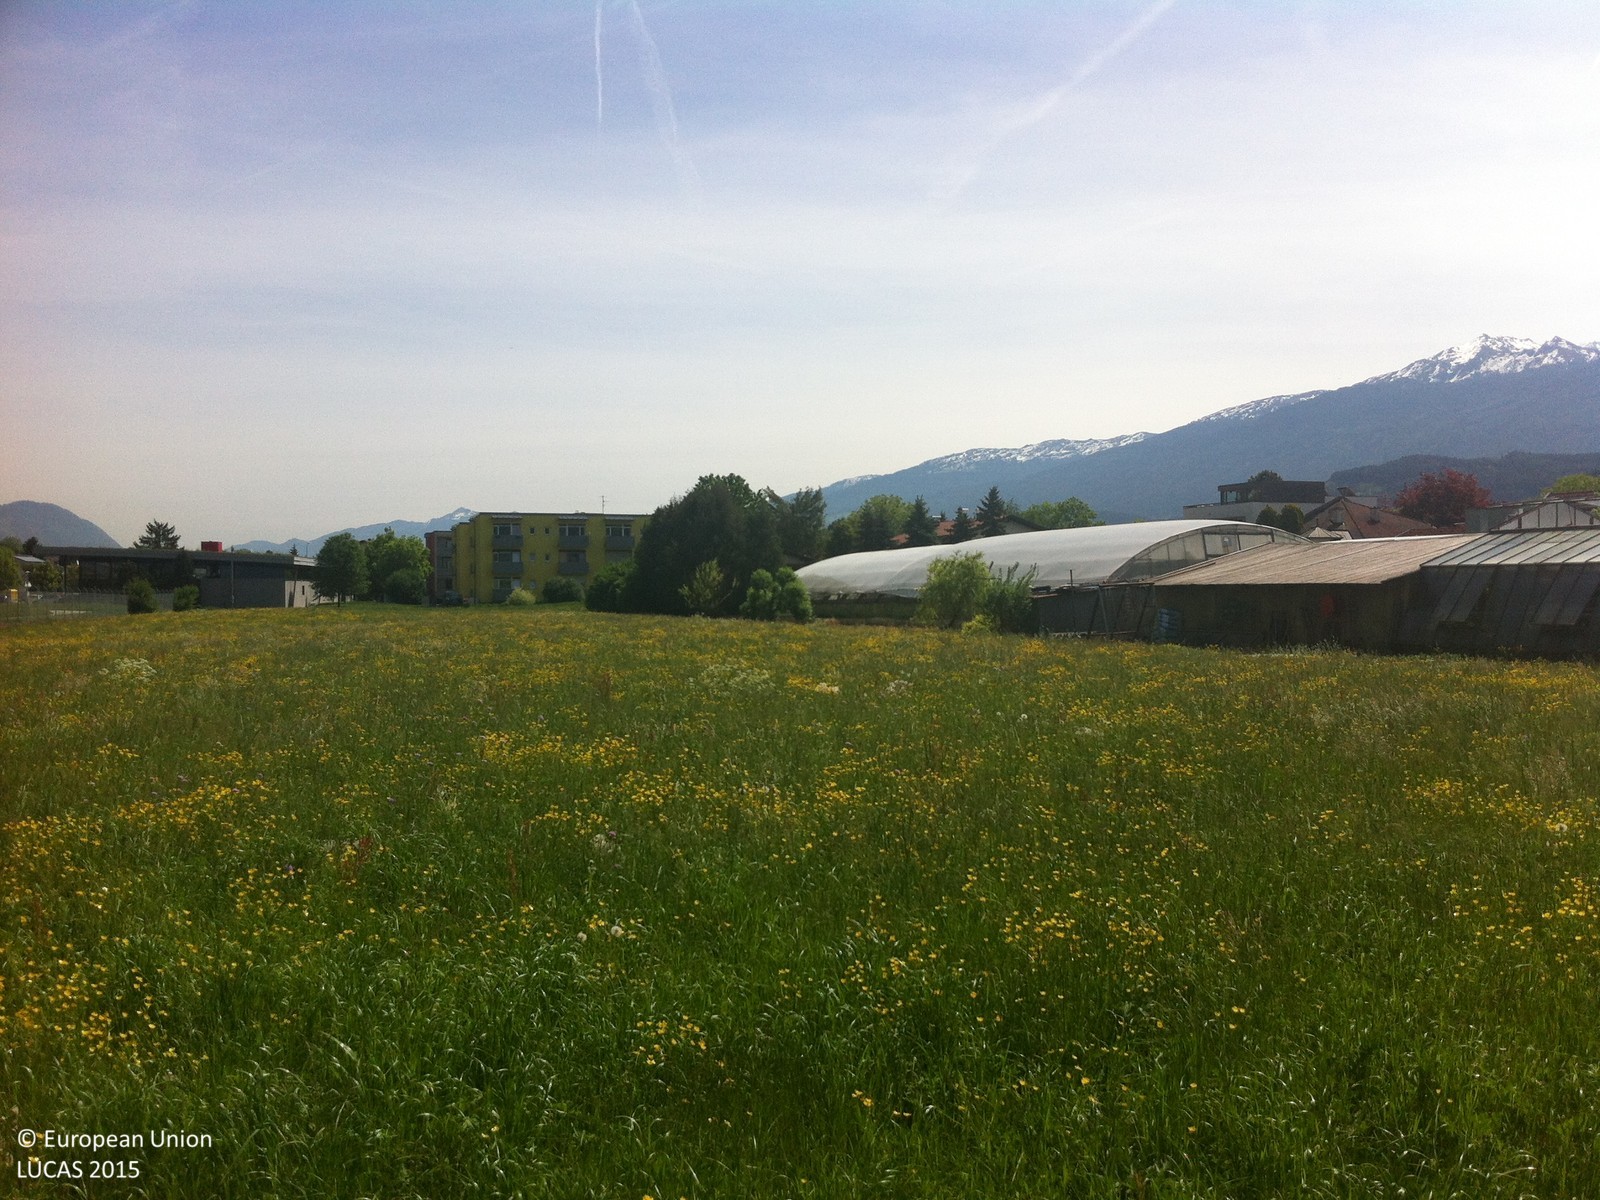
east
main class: Grassland
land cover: Grassland without tree/shrub cover
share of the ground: > 75 %
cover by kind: herbaceous plants 100 %
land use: Air transport
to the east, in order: Grassland without tree/shrub cover; Paved roads, cycling and walking lanes; Grassland without tree/shrub cover; Paved roads, cycling and walking lanes; Grassland without tree/shrub cover; Fences; Grassland without tree/shrub cover; Managed hedges; Artificial constructions in urban areas
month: May
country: AT
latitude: 47.2611
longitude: 11.3599
